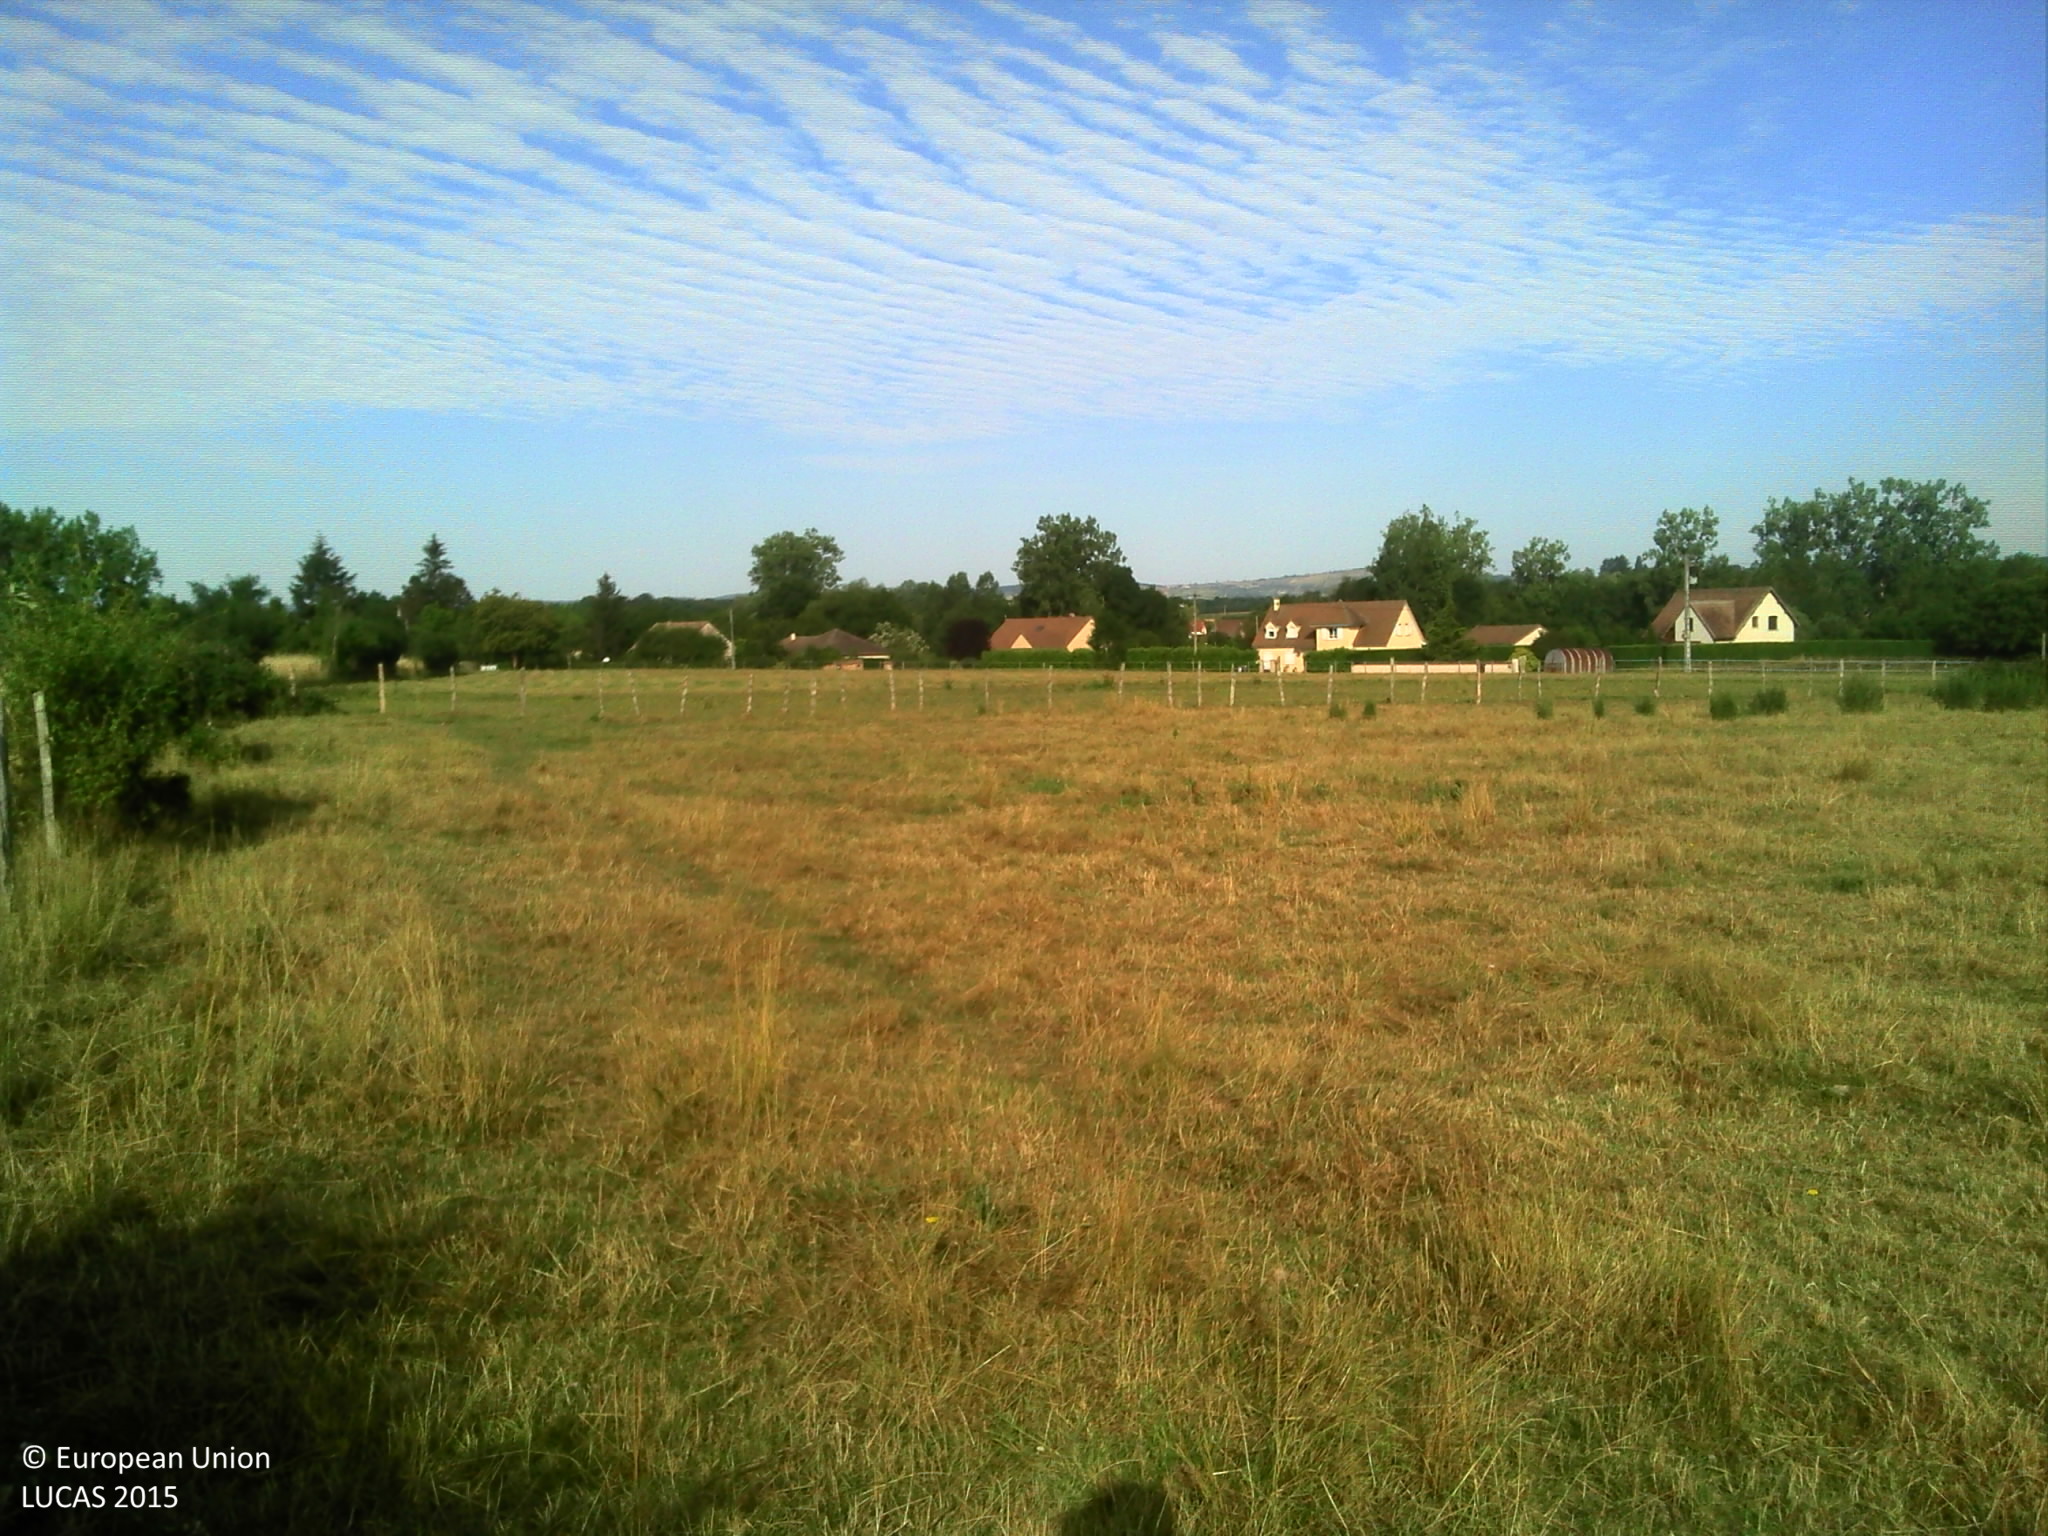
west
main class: Grassland
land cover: Grassland without tree/shrub cover
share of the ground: > 75 %
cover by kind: herbaceous plants 100 %
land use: Agriculture (excluding fallow land and kitchen gardens)
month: June
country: FR
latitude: 46.7303
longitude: 4.8064
